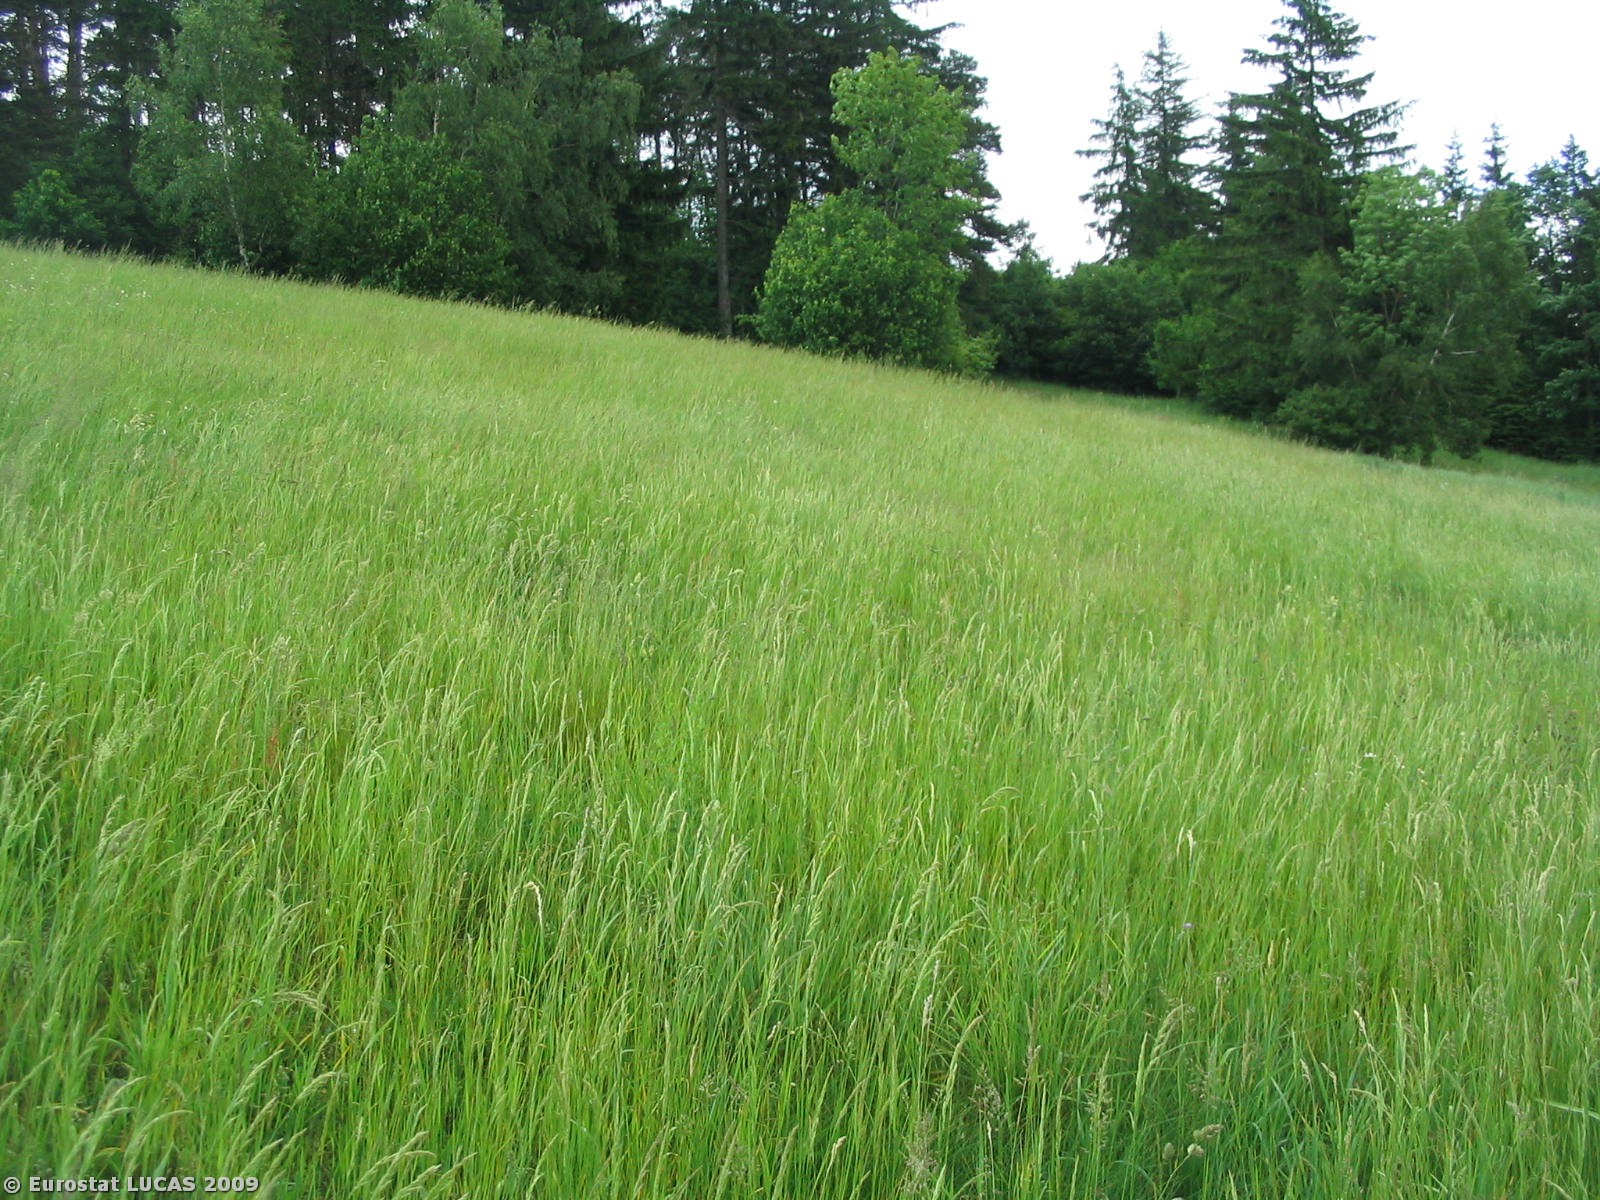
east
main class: Grassland
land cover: Grassland without tree/shrub cover
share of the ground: > 75 %
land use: Agriculture (excluding fallow land and kitchen gardens)
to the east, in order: Grassland without tree/shrub cover; Tracks; Grassland without tree/shrub cover; Mixed woodland
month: May
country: CZ
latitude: 49.4946
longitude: 16.4823
